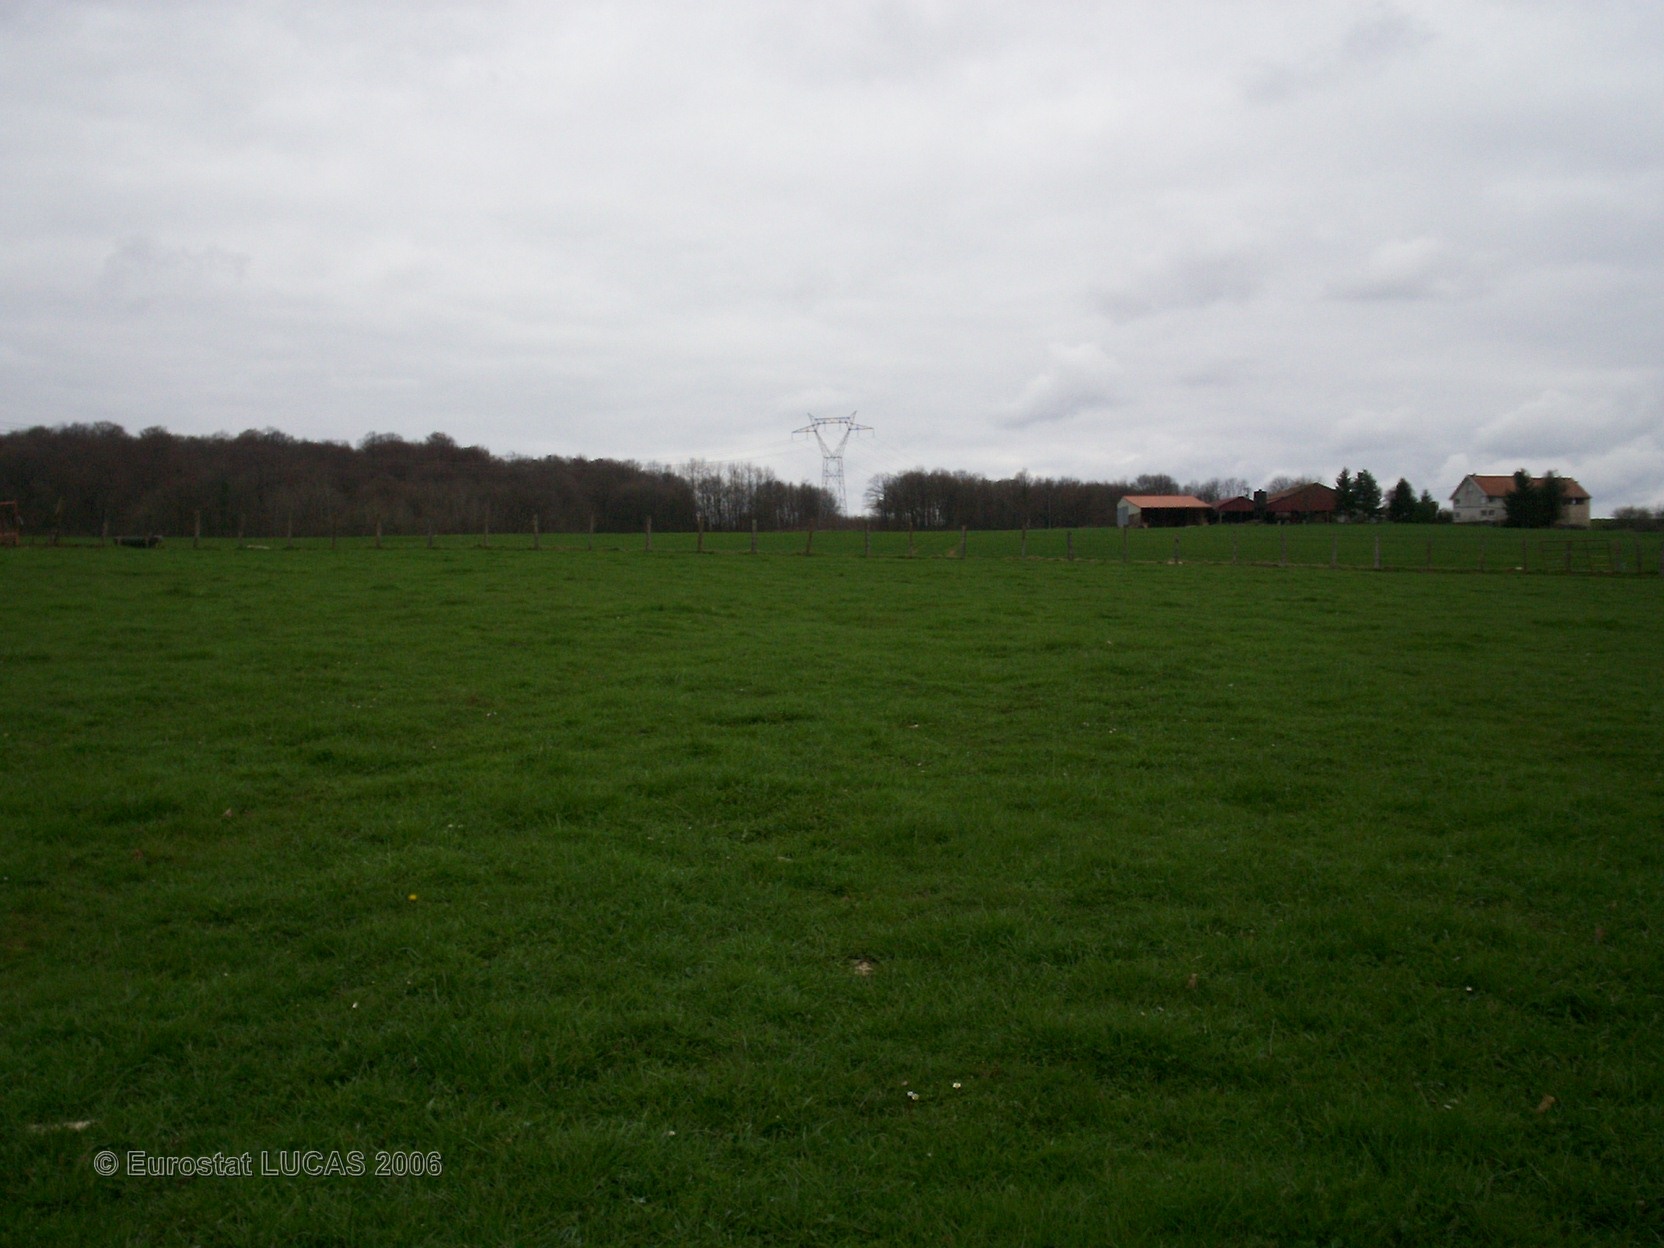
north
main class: Grassland
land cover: Grassland without tree/shrub cover
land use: Agriculture (excluding fallow land and kitchen gardens)
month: April
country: FR
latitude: 47.5647
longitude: 6.7984
